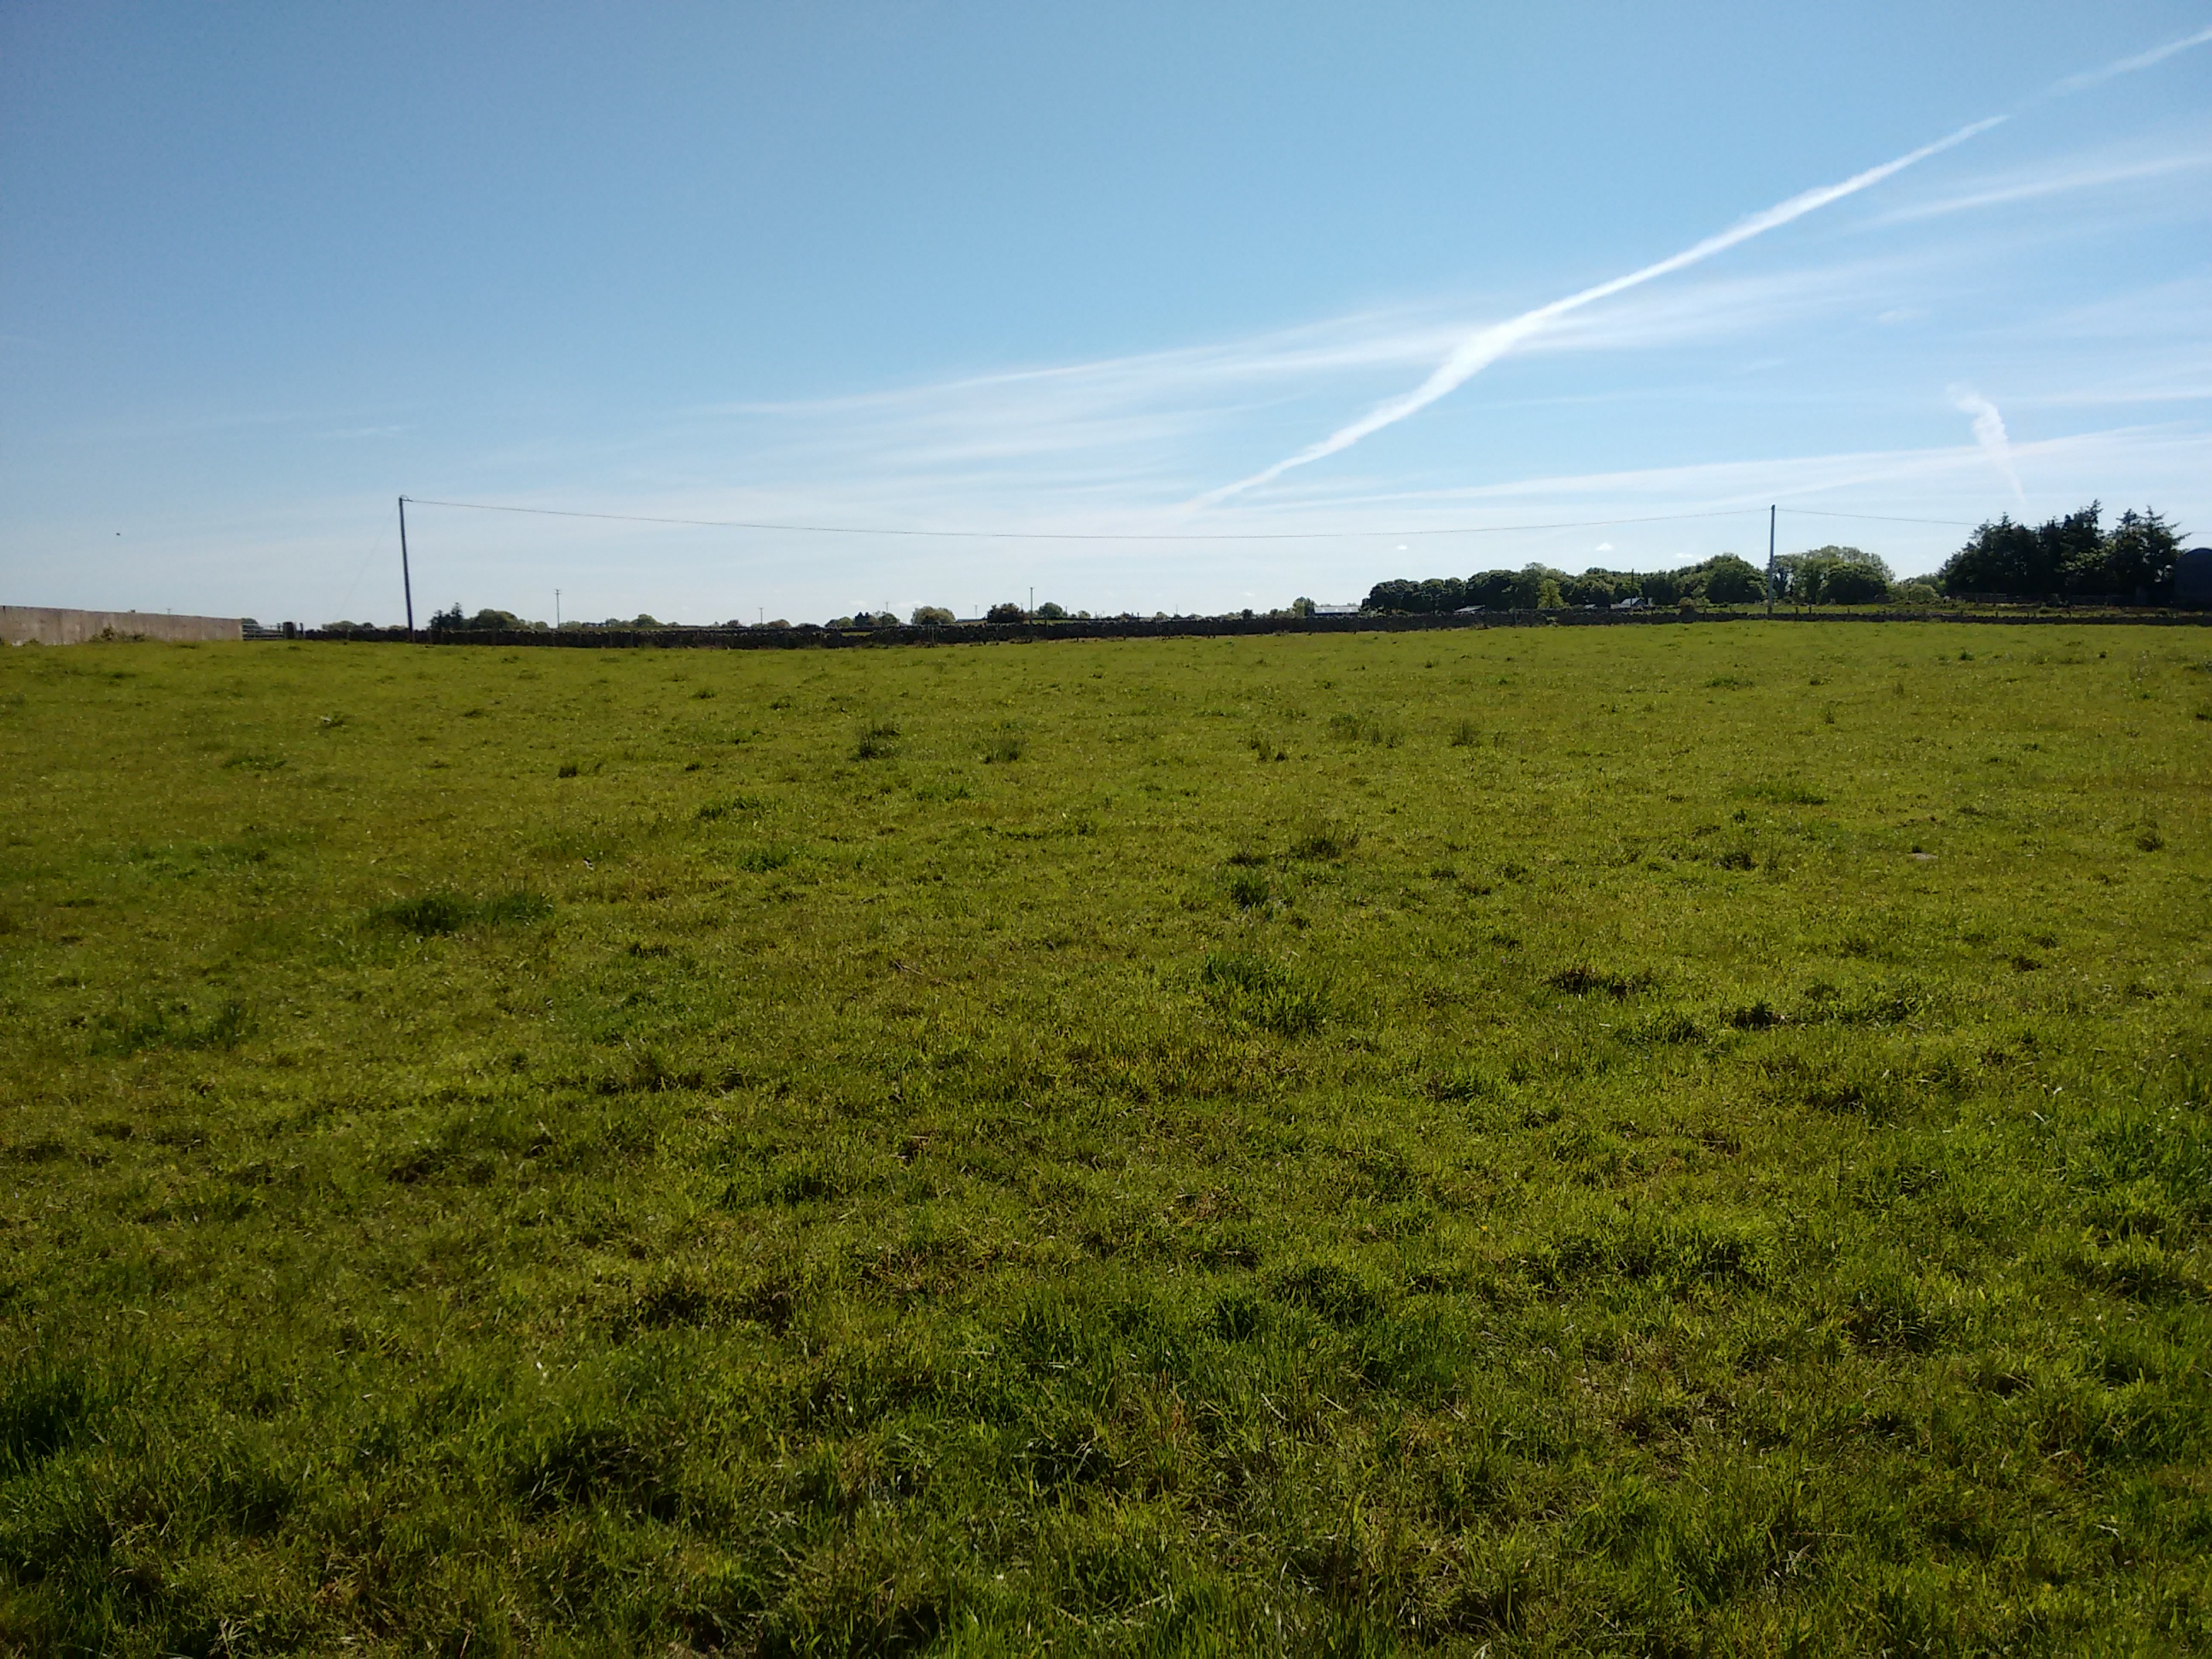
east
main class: Grassland
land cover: Grassland without tree/shrub cover
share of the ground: > 75 %
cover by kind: herbaceous plants 100 %
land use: Agriculture (excluding fallow land and kitchen gardens)
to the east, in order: Grassland without tree/shrub cover; Dry stone walls; Grassland without tree/shrub cover; Electric lines; Grassland without tree/shrub cover; Fences; Paved roads, cycling and walking lanes; Grass margins; Fences; Electric lines; Dry stone walls; Grassland without tree/shrub cover; Dry stone walls; Grassland without tree/shrub cover
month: June
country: IE
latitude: 53.2167
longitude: -8.6026
